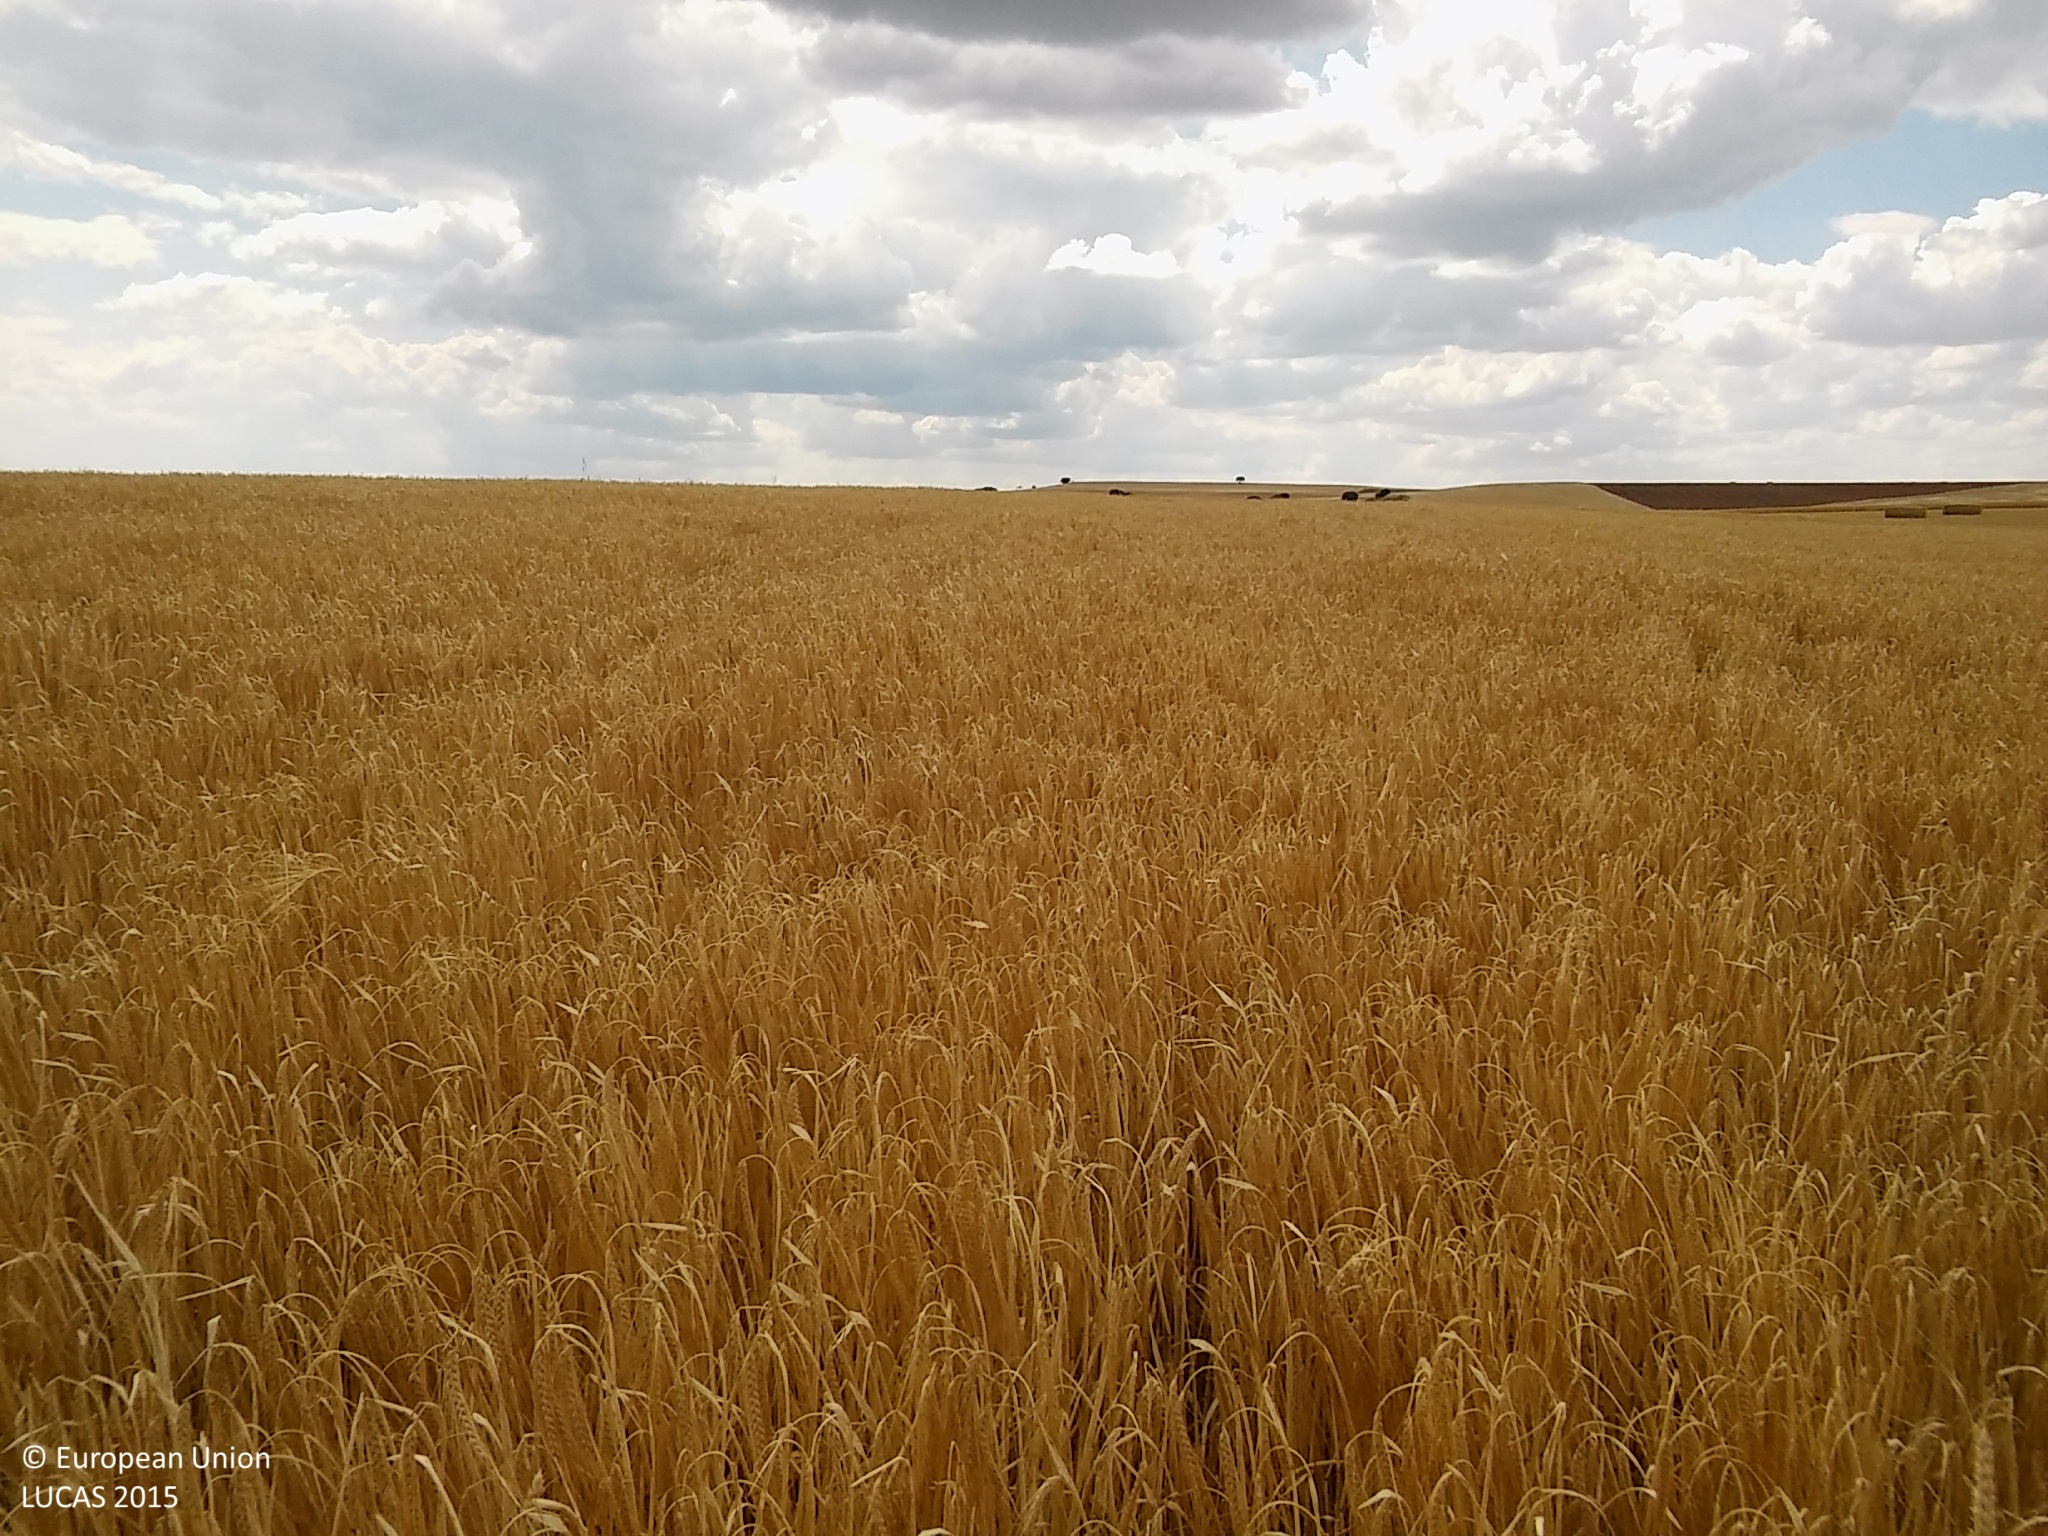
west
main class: Cropland
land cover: Barley
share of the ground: > 75 %
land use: Agriculture (excluding fallow land and kitchen gardens)
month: June
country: ES
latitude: 41.3363
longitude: -3.6830
